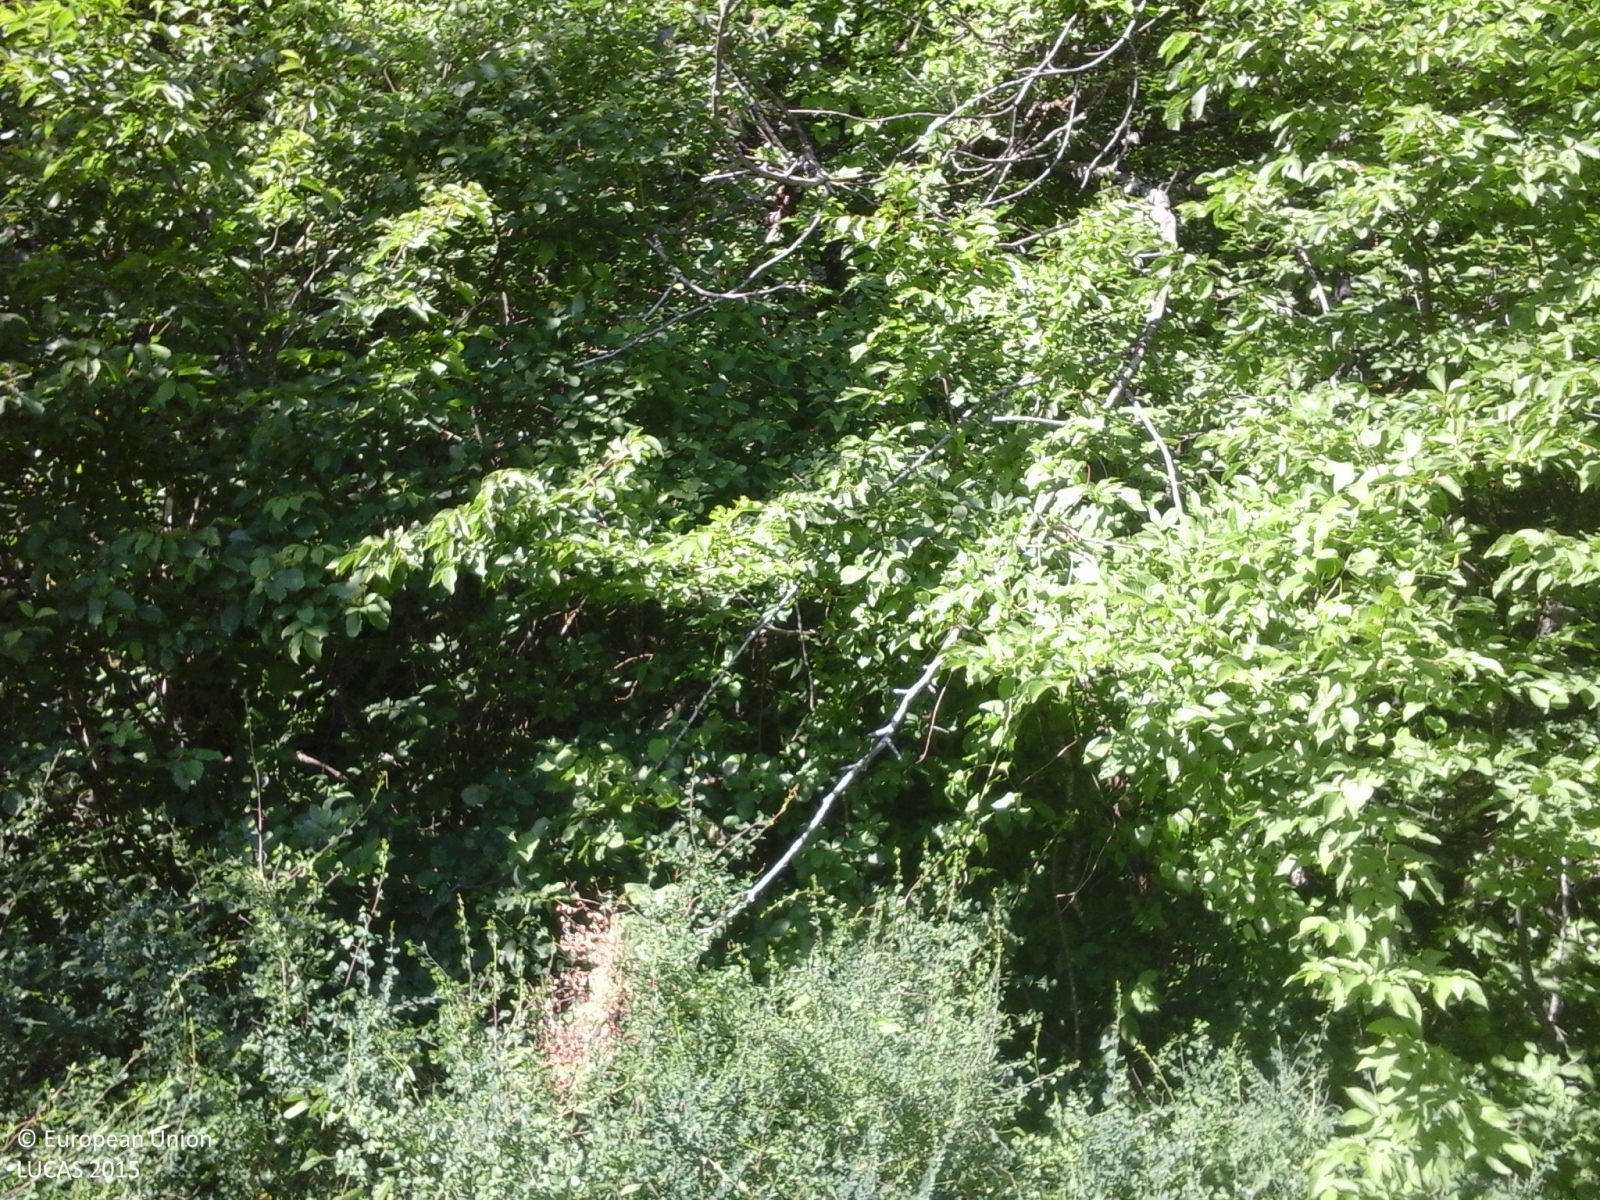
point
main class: Woodland
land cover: Broadleaved woodland
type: thermophilous deciduous forest
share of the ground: > 75 %
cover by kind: broadleaved forest trees 100 %
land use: Forestry
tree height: > 5 m
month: June
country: IT
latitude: 44.5127
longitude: 10.1883
